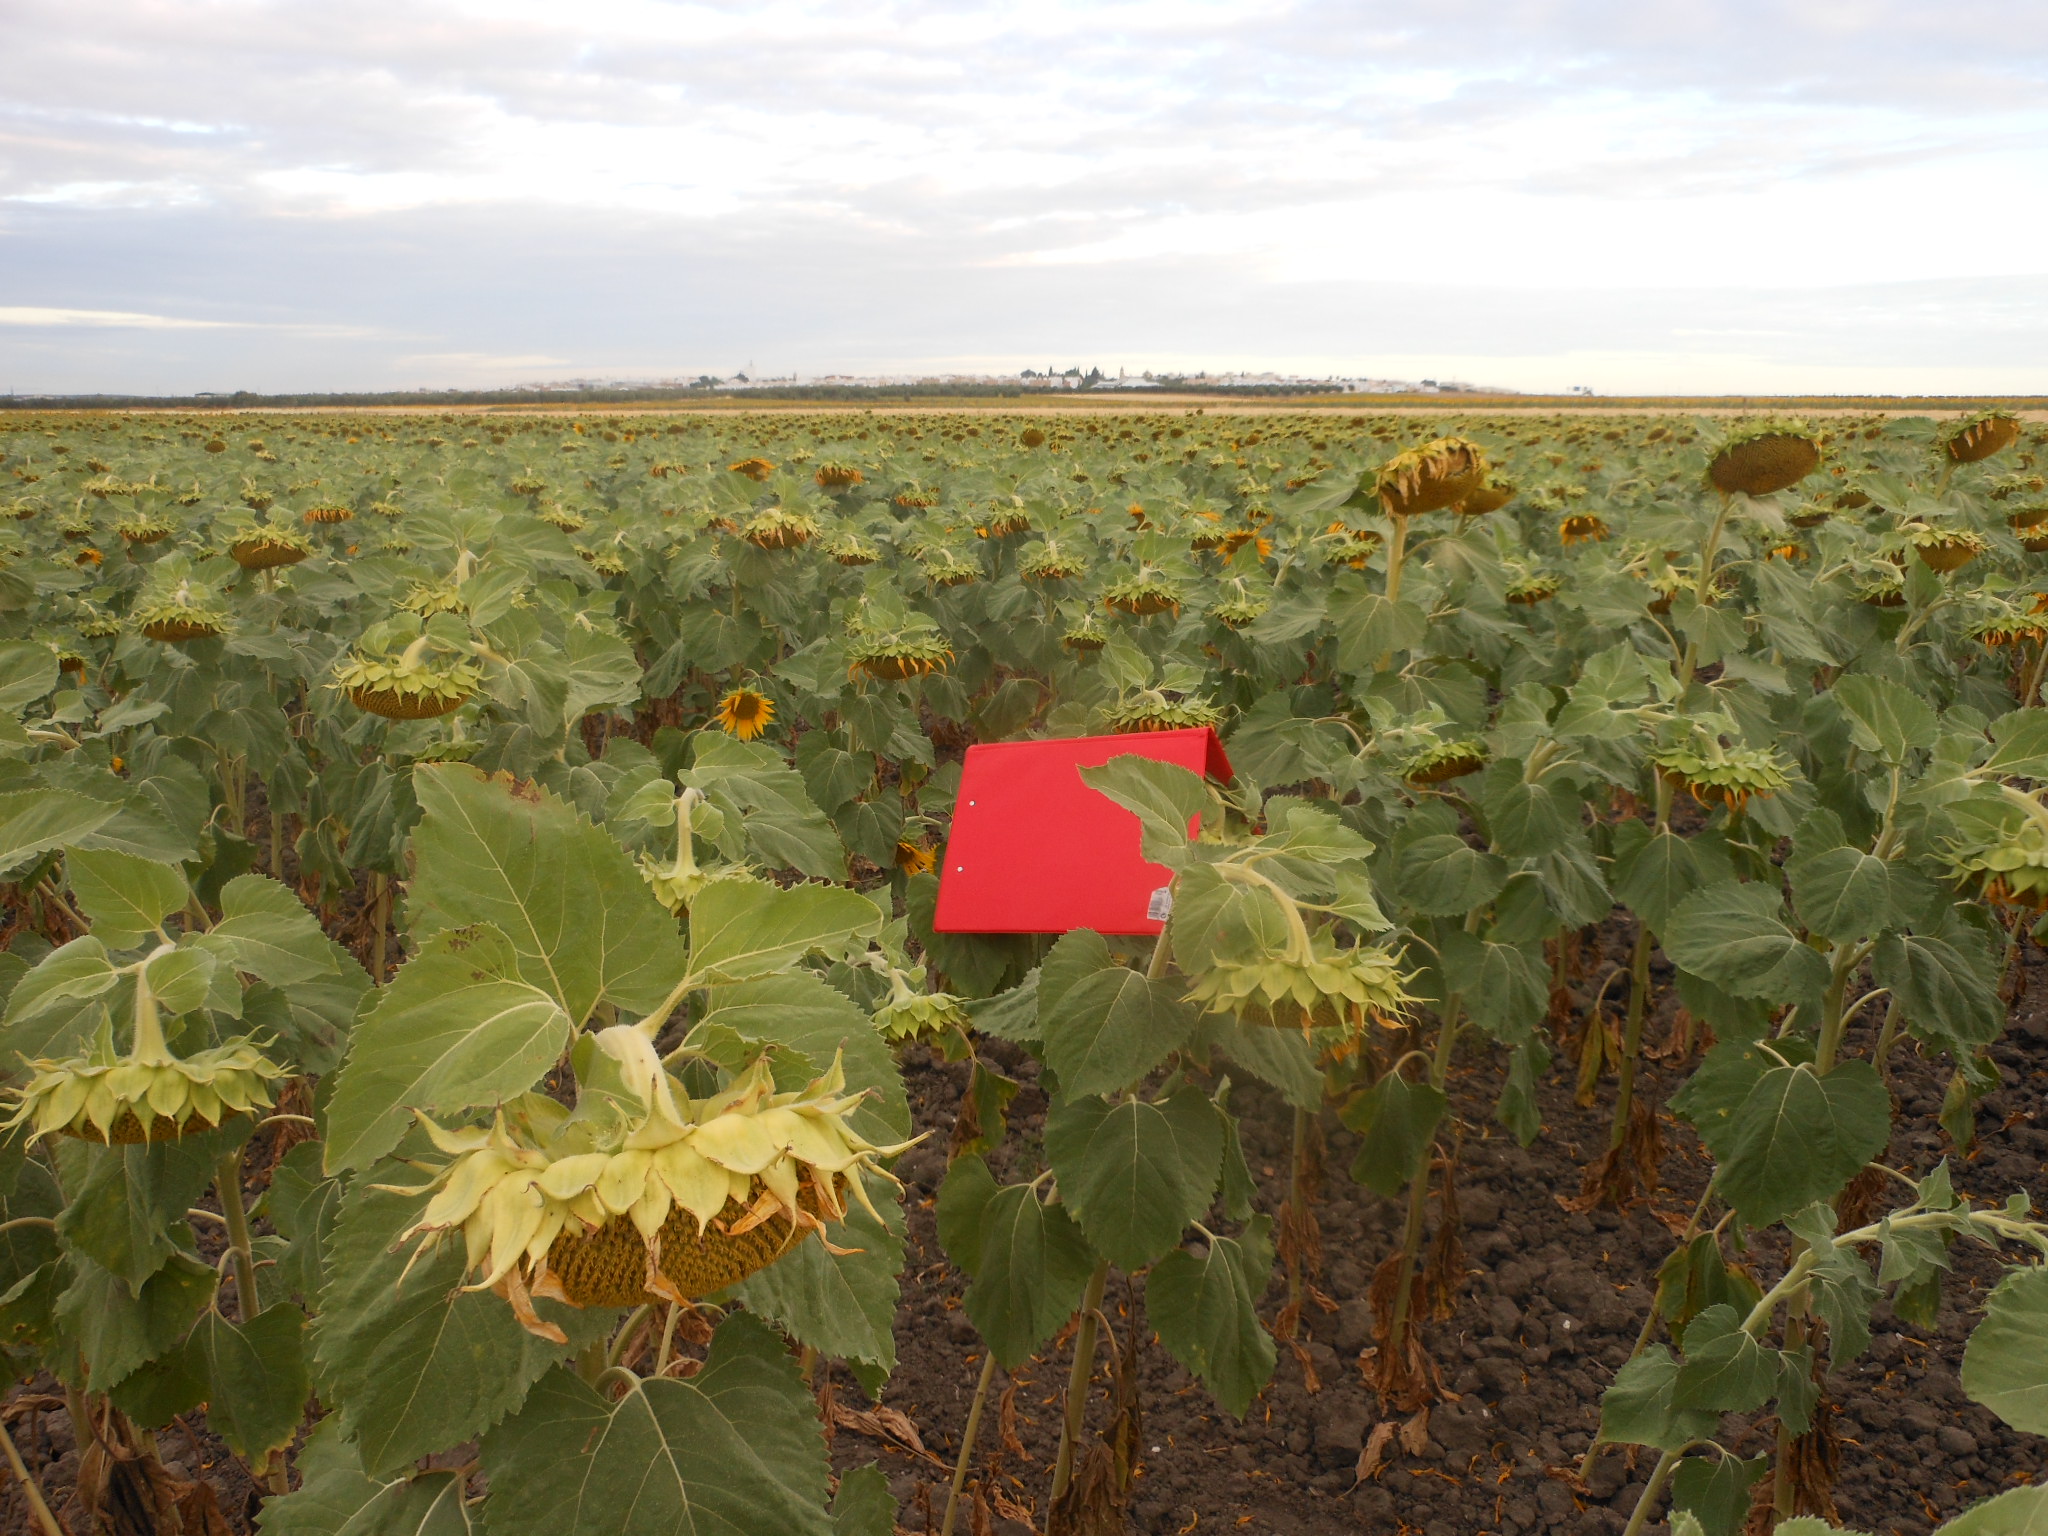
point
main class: Cropland
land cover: Sunflower
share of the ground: 50 - 75 %
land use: Agriculture (excluding fallow land and kitchen gardens)
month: June
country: ES
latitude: 37.2576
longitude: -5.5171
